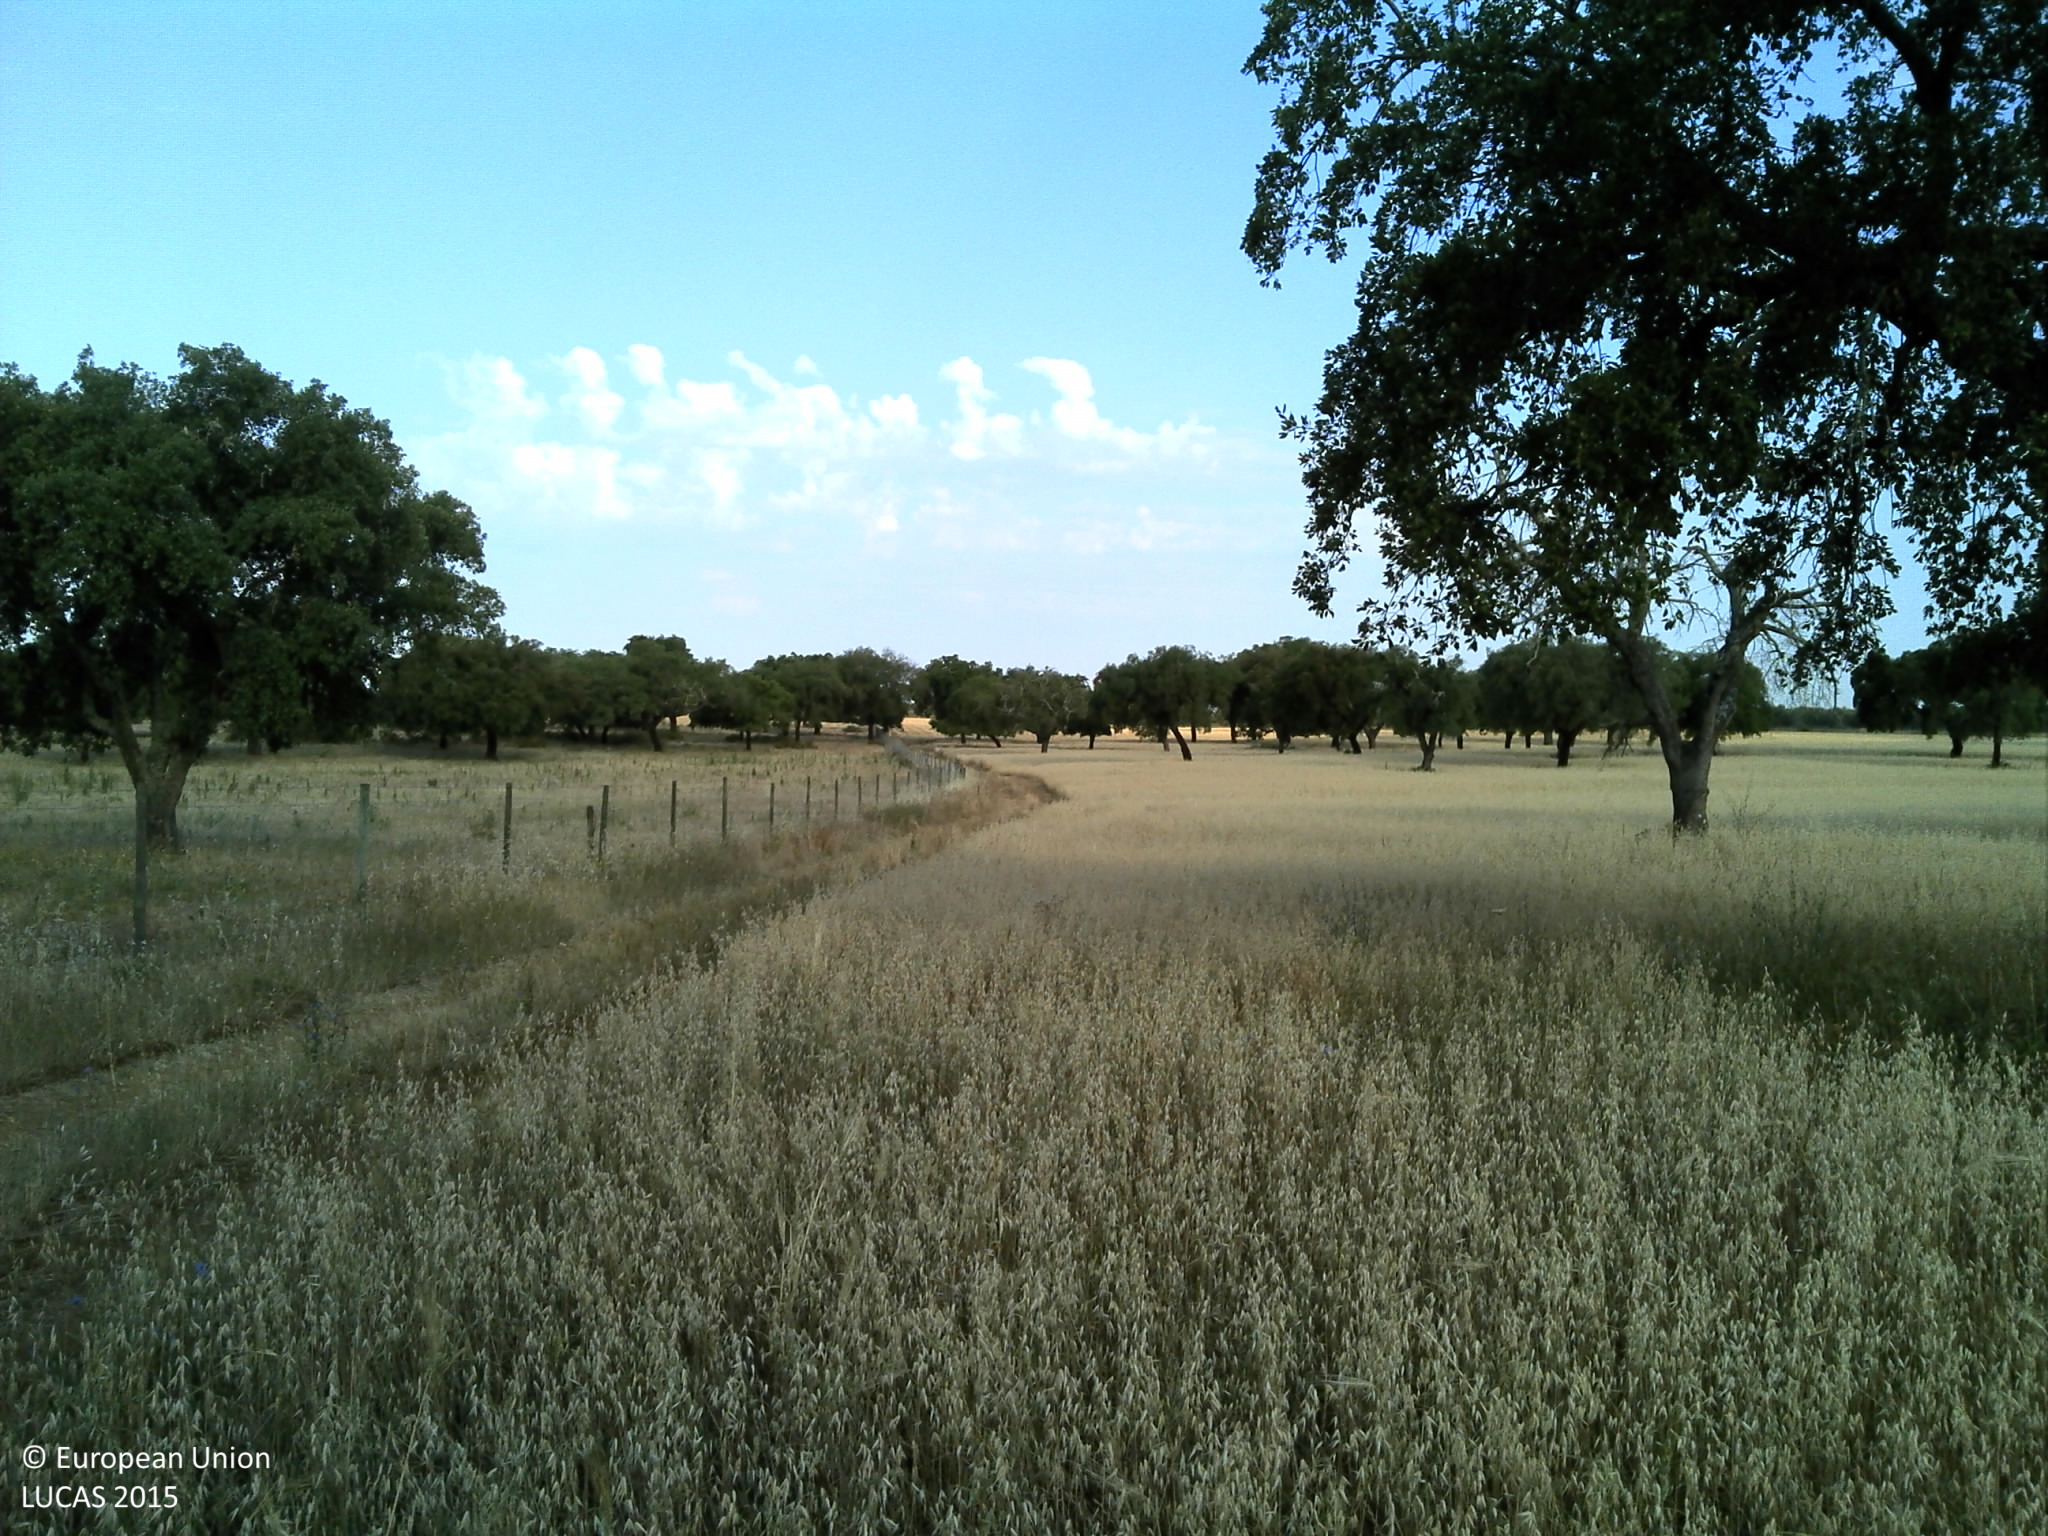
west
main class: Woodland
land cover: Broadleaved woodland
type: broadleaved evergreen forest
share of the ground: 25 - 50 %
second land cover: Oats
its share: > 75 %
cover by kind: herbaceous plants 60 %, broadleaved forest trees 30 %, unconsolidated bare surface 10 %
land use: Forestry
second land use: Agriculture (excluding fallow land and kitchen gardens)
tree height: > 5 m
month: May
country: PT
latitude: 38.9433
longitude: -7.7764
